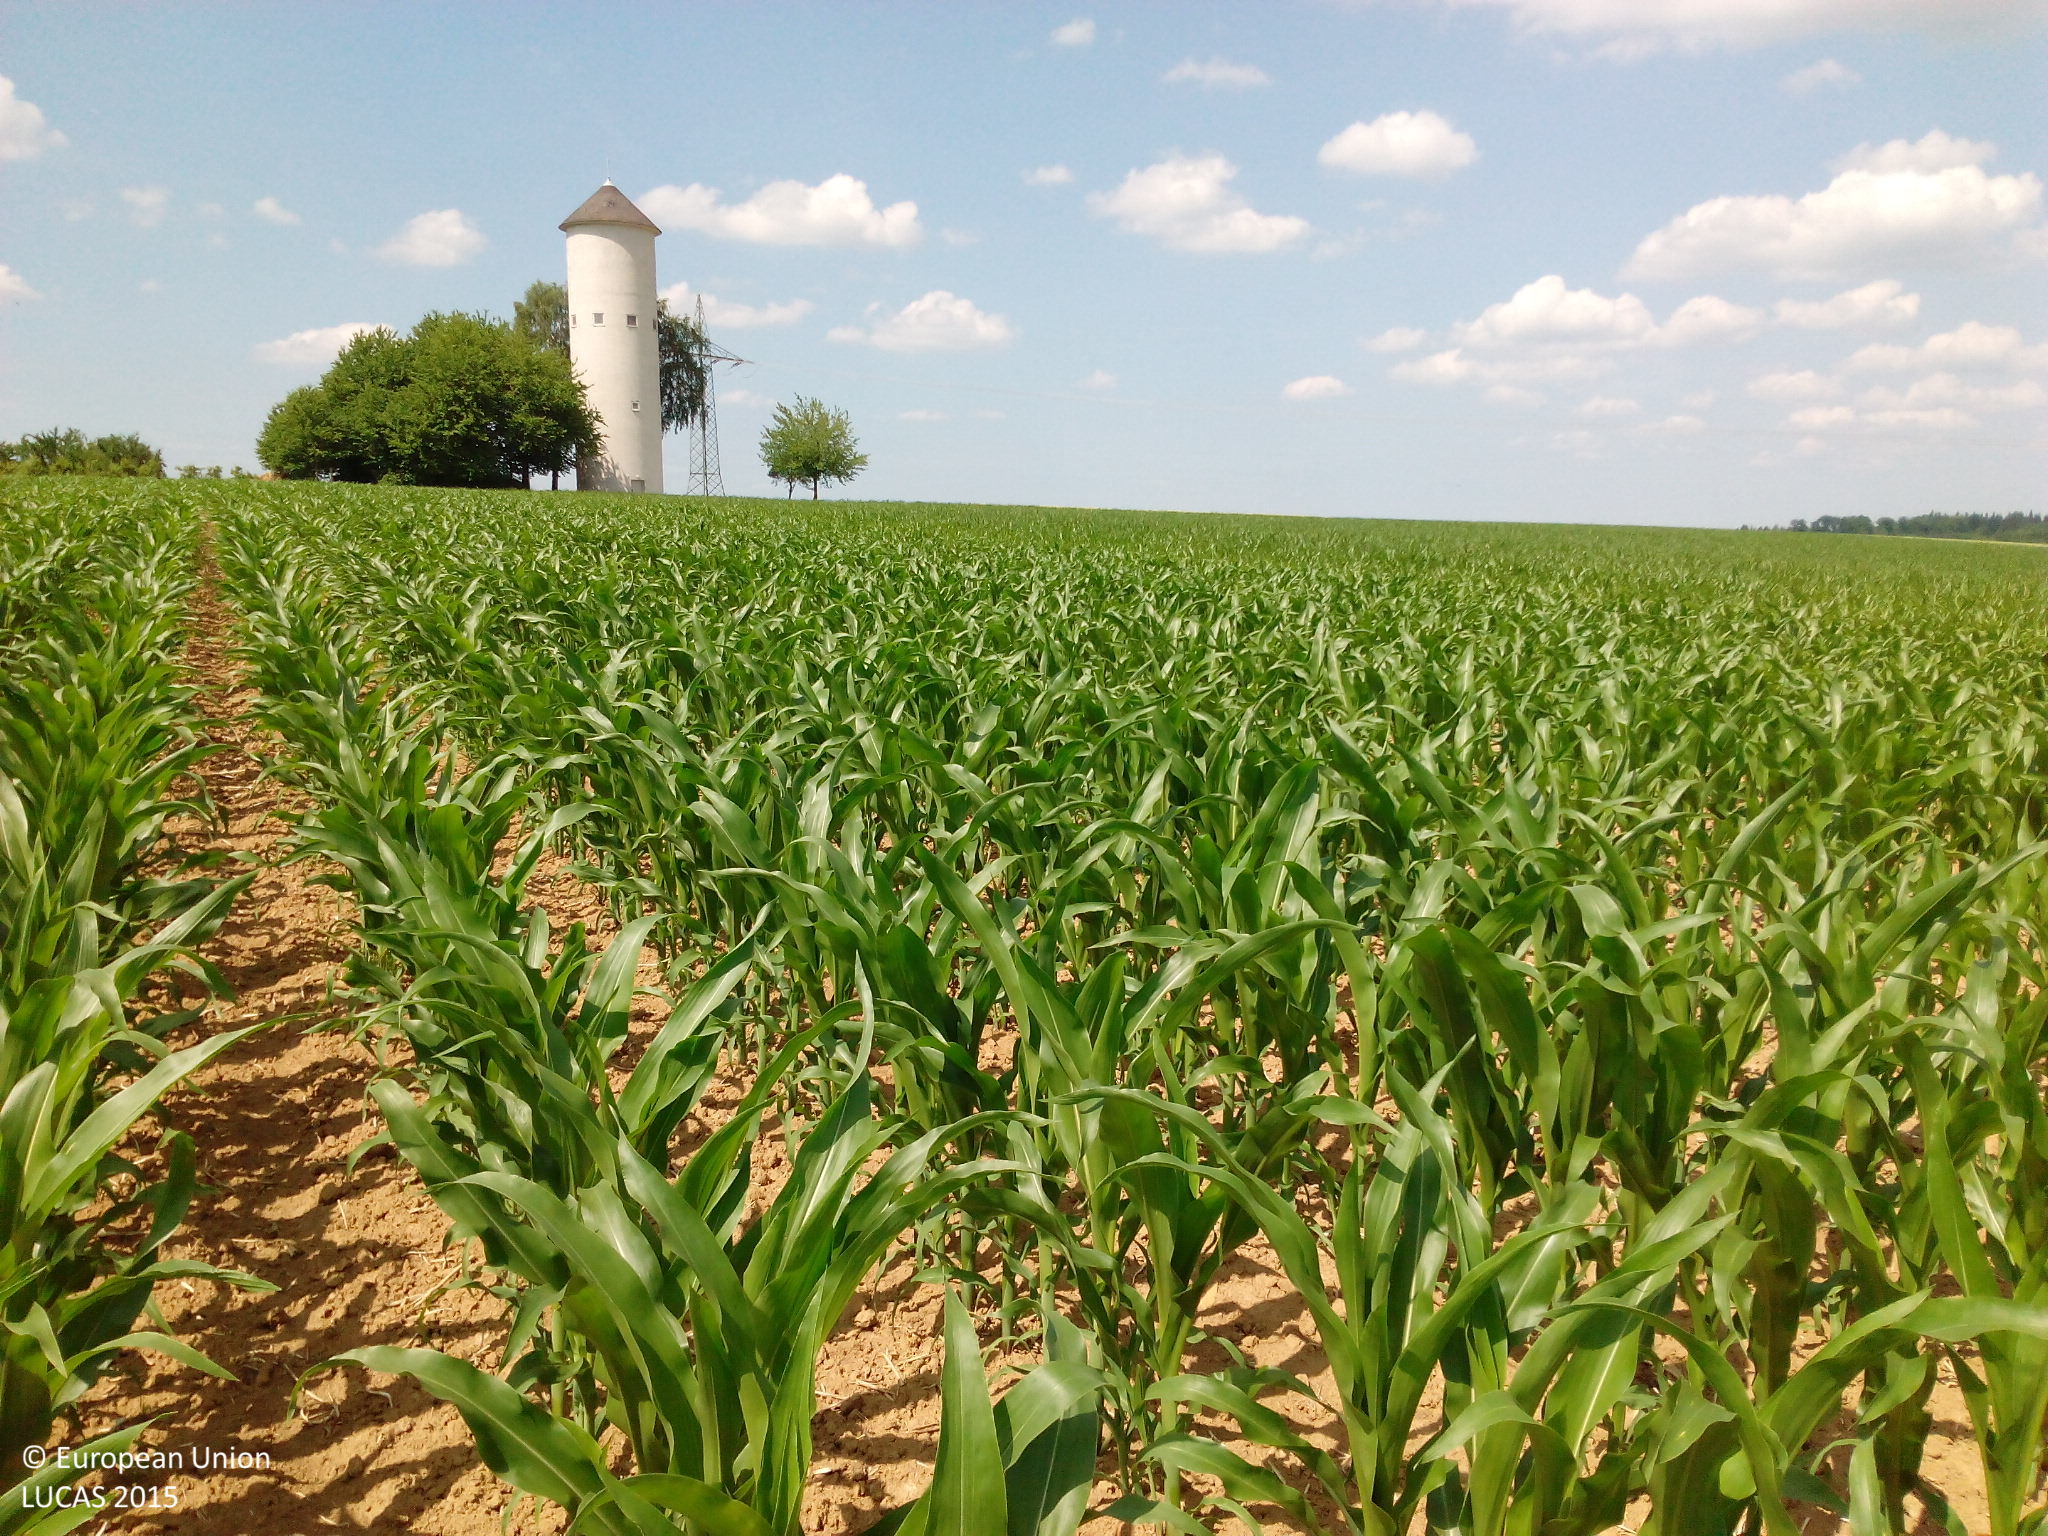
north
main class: Cropland
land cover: Maize
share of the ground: > 75 %
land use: Agriculture (excluding fallow land and kitchen gardens)
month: June
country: DE
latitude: 49.2662
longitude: 9.5742
